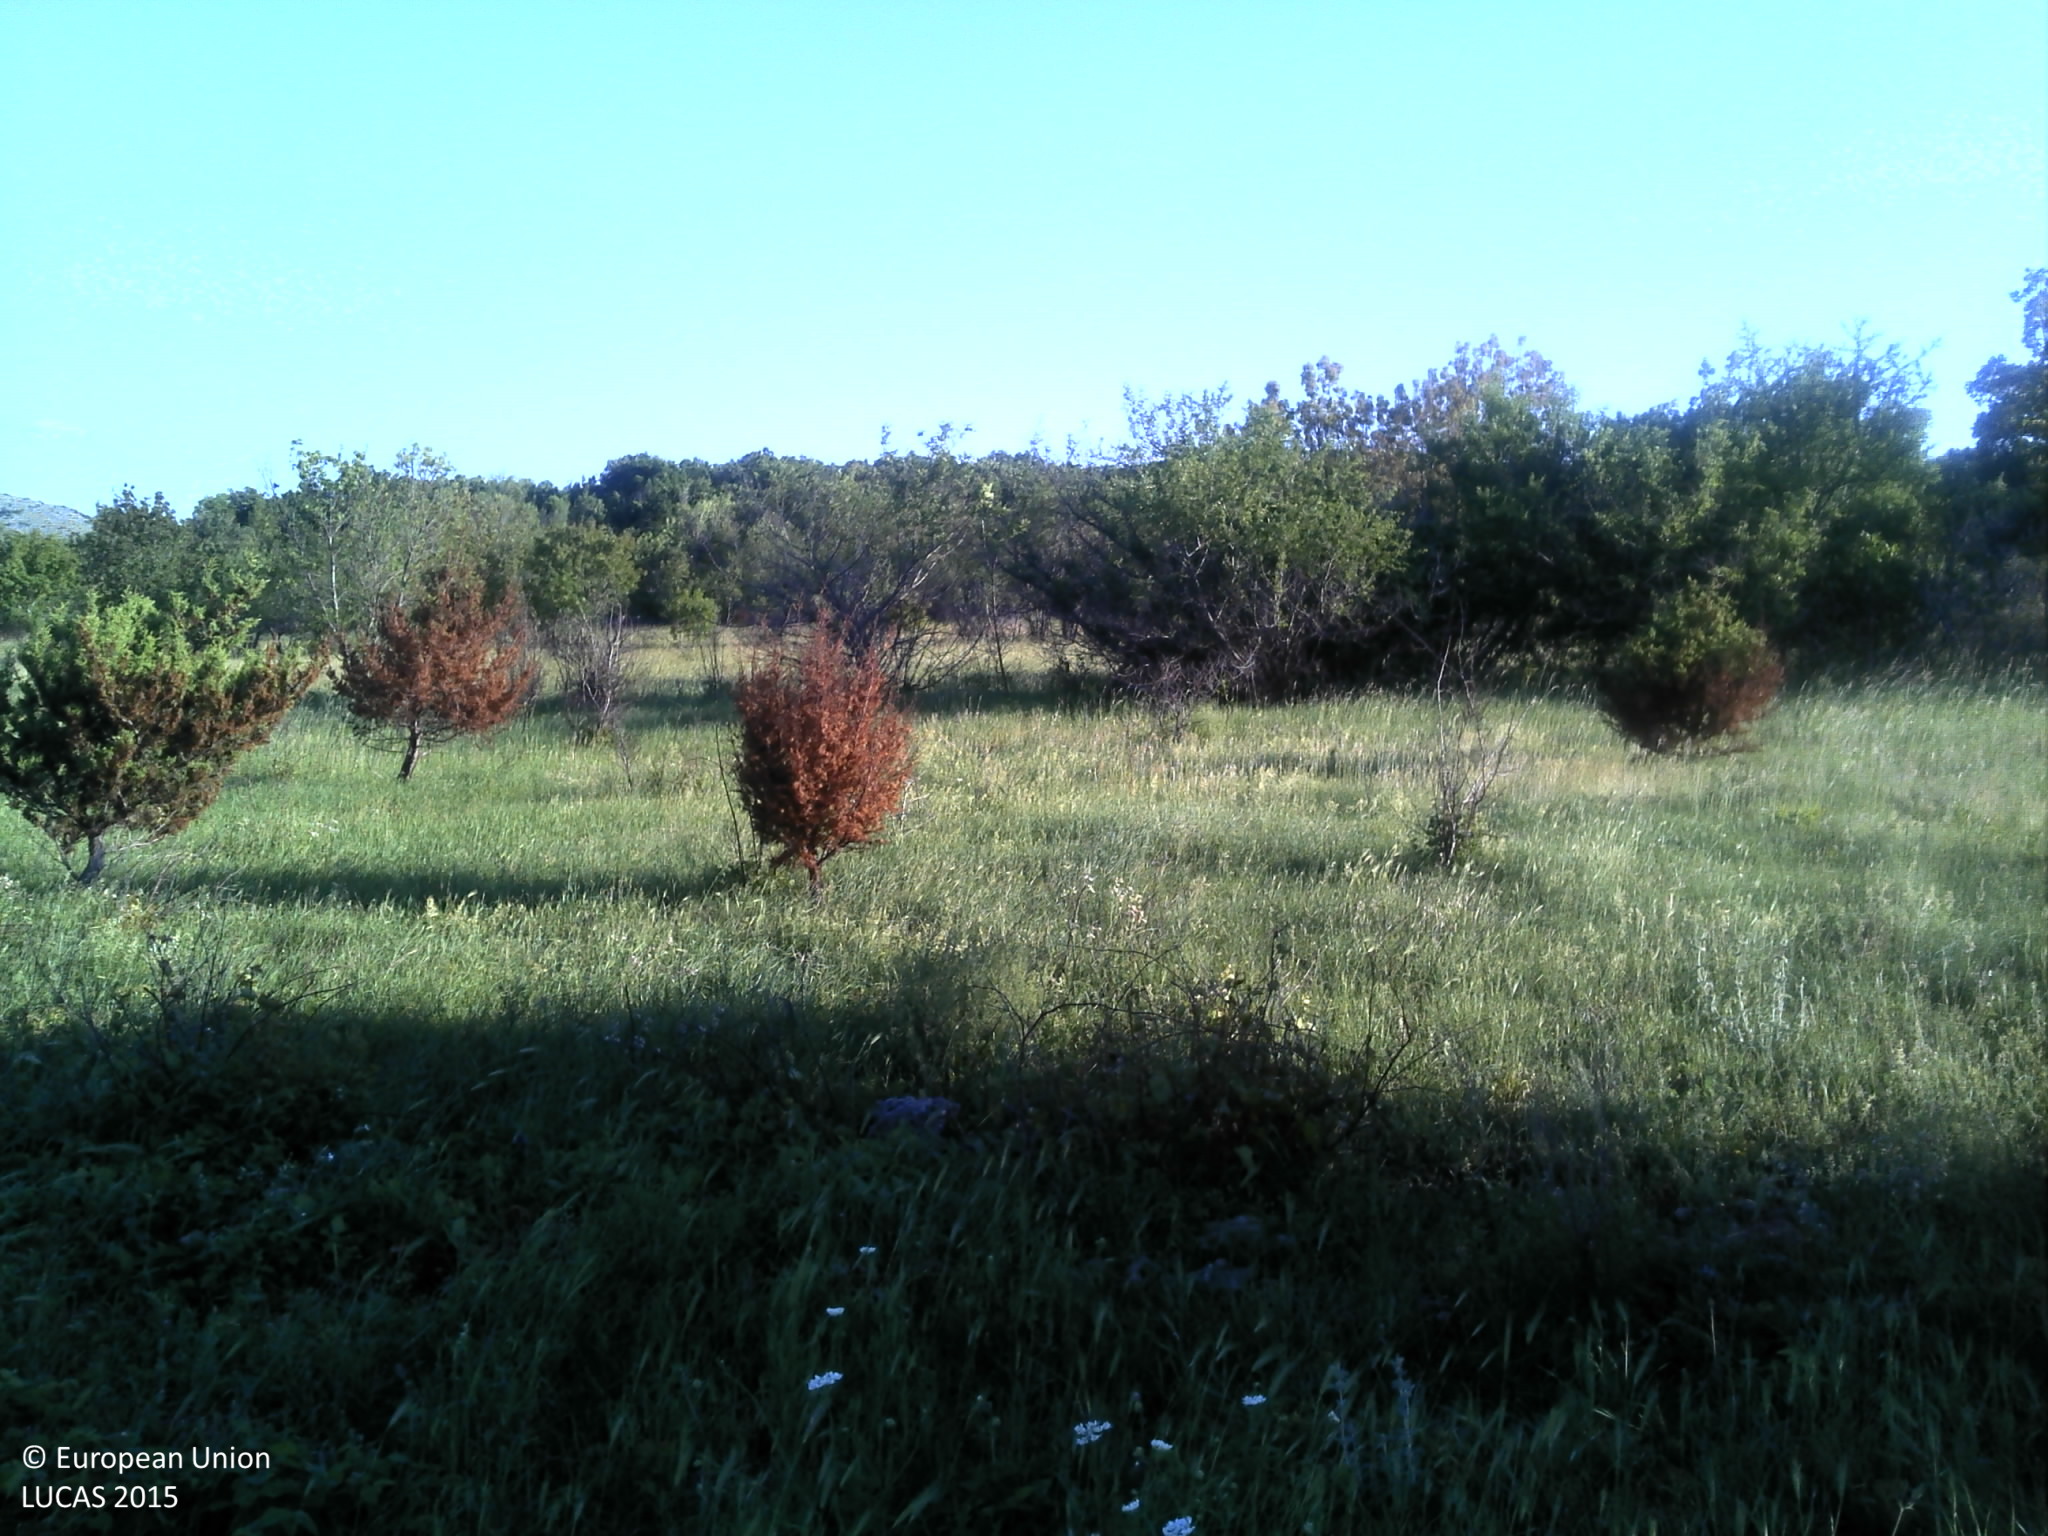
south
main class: Grassland
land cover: Grassland with sparse tree/shrub cover
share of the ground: 10 - 25 %
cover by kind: herbaceous plants 85 %, shrubs 10 %, broadleaved forest trees 5 %
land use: Semi-natural and natural areas not in use
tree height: < 5 m
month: May
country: HR
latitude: 44.1166
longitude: 16.1029
